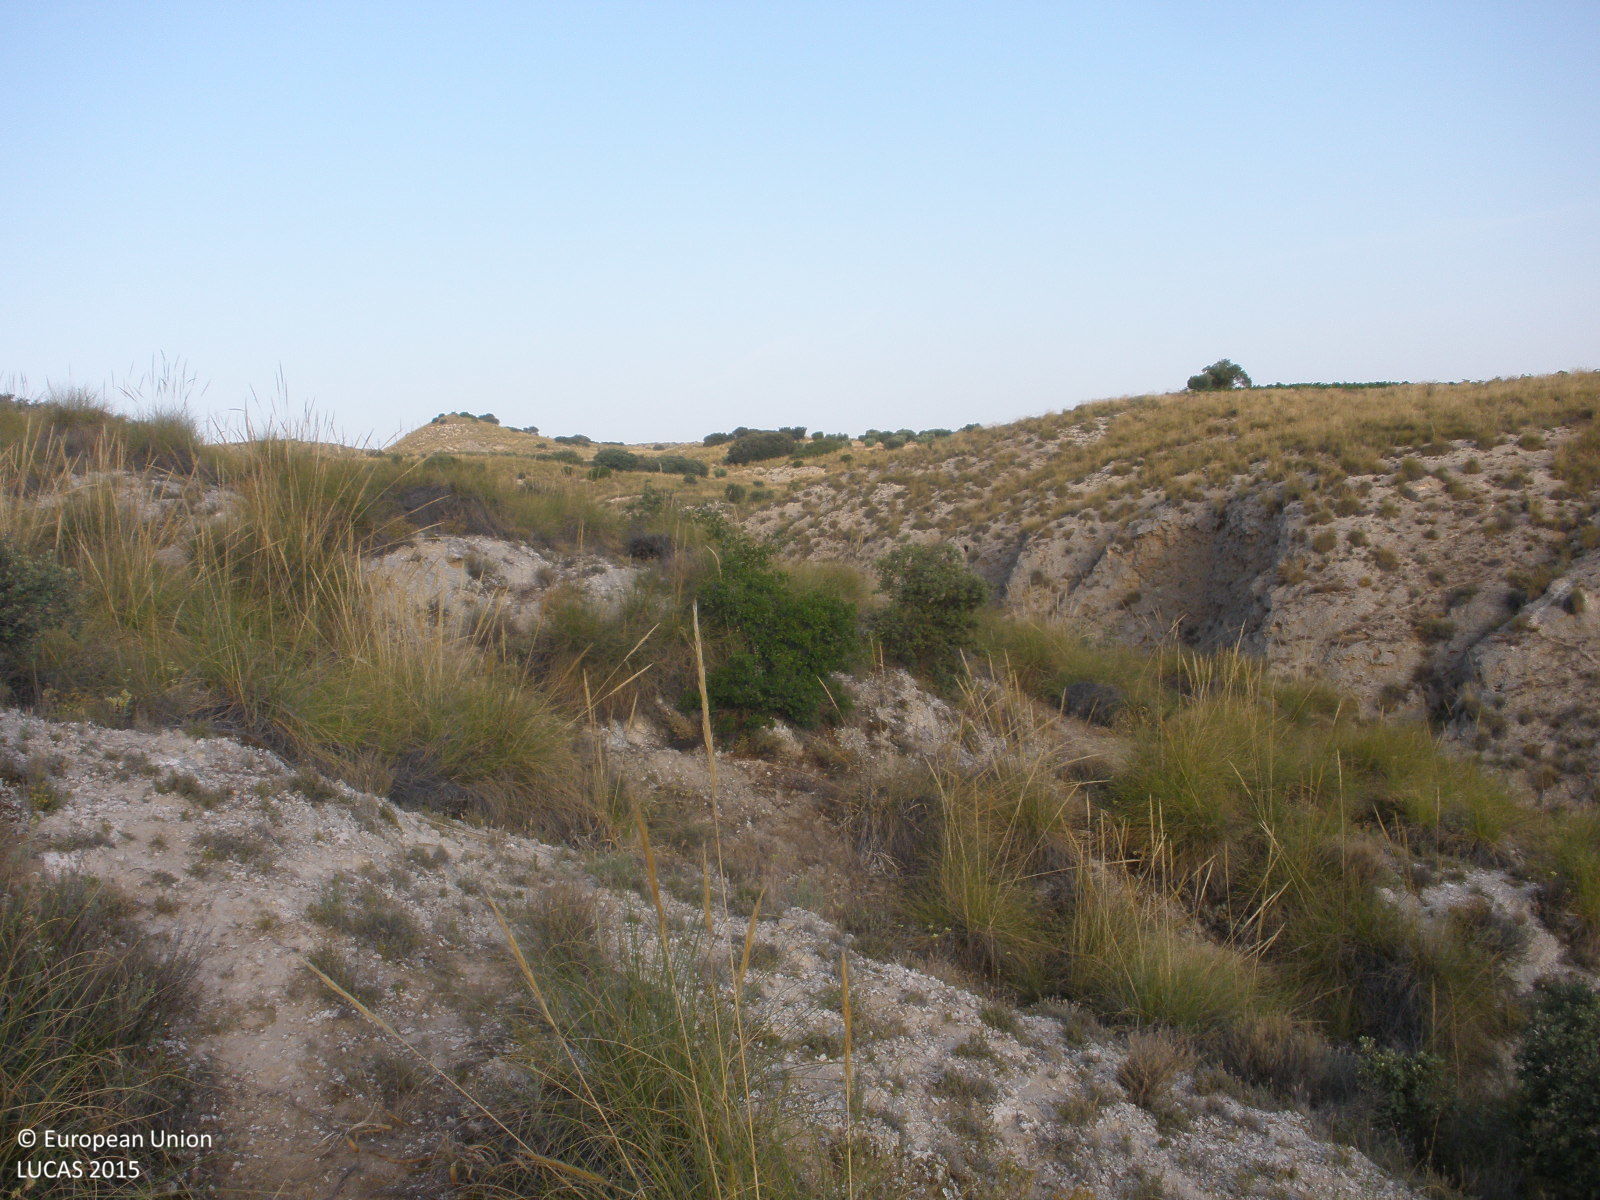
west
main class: Woodland
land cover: Broadleaved woodland
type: broadleaved evergreen forest
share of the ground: 10 - 25 %
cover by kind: shrubs 40 %, herbaceous plants 30 %, broadleaved forest trees 20 %, consolidated bare surface 10 %
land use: Semi-natural and natural areas not in use
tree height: < 5 m
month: July
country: ES
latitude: 40.0214
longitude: -3.3975
